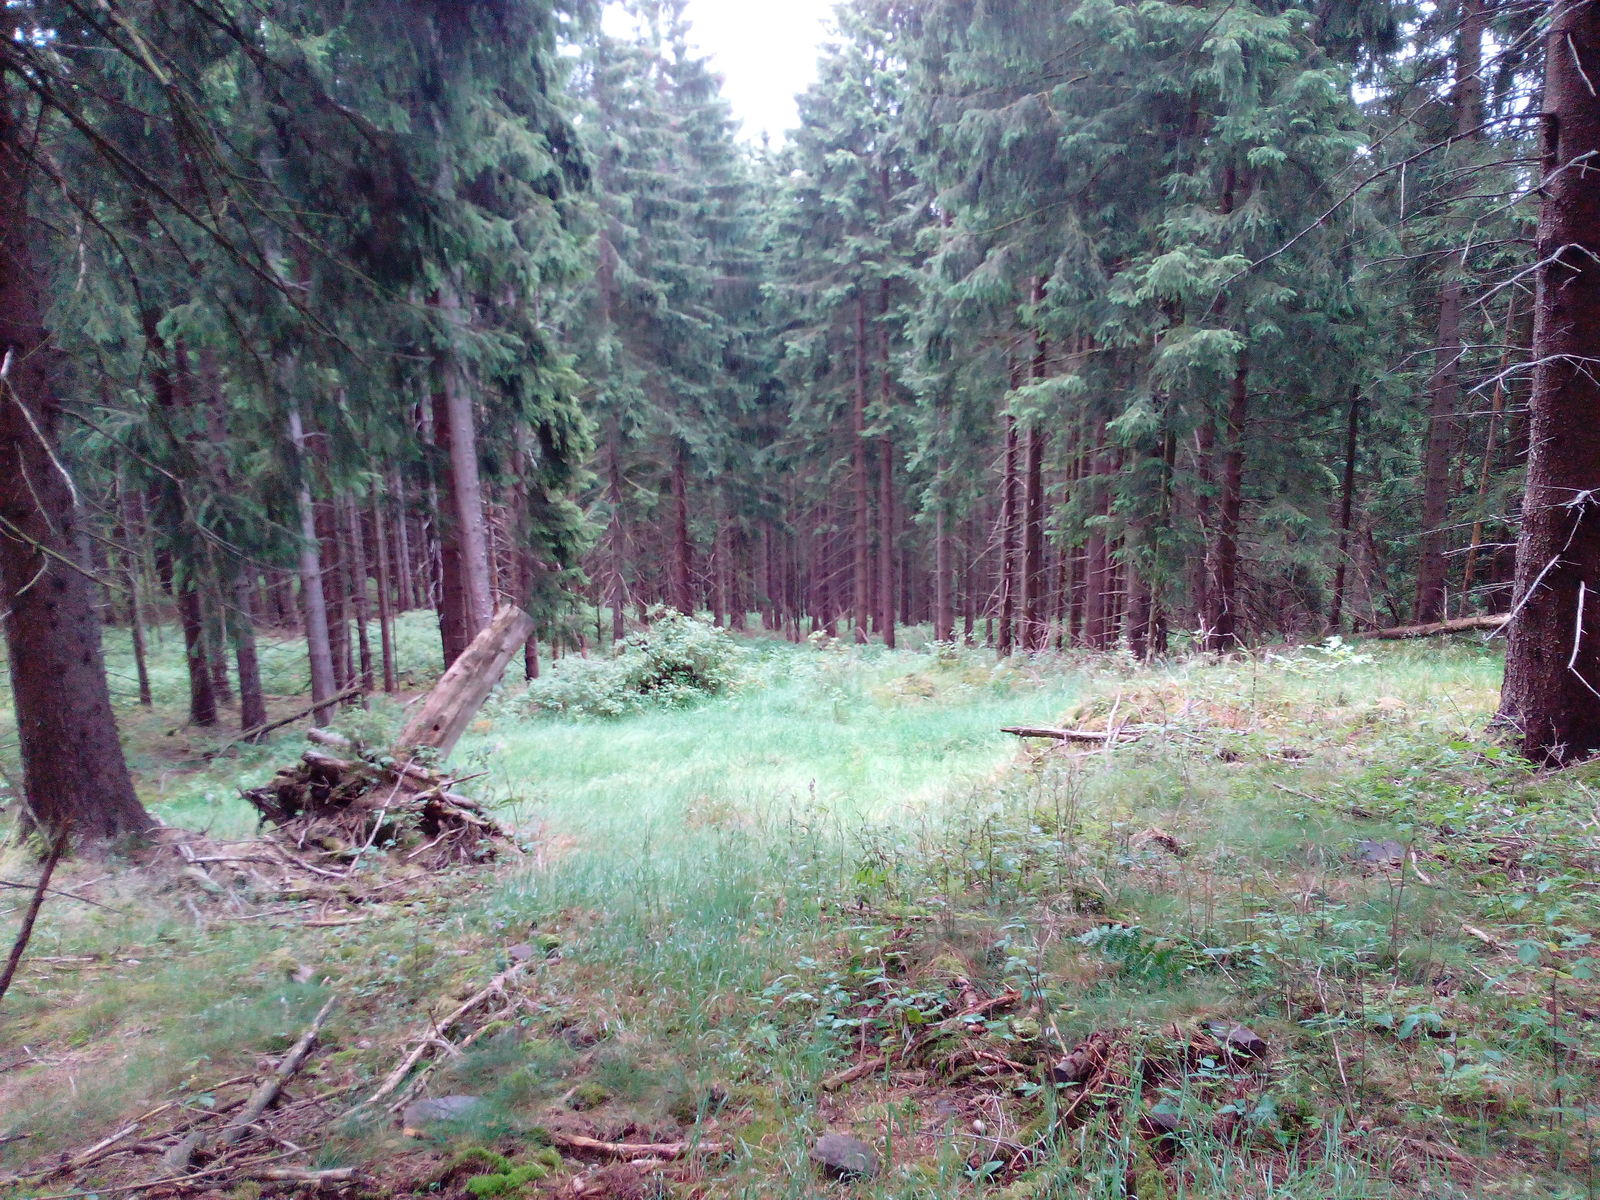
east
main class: Woodland
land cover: Spruce dominated coniferous woodland
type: hemiboreal forest and nemoral coniferous forest and mixed broadleaved-coniferous forest
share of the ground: > 75 %
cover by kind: coniferous forest trees 85 %, herbaceous plants 10 %, shrubs 5 %
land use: Forestry
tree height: > 5 m
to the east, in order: Spruce dominated coniferous woodland; Tracks; Spruce dominated coniferous woodland
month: July
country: DE
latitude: 50.6298
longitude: 10.9469
